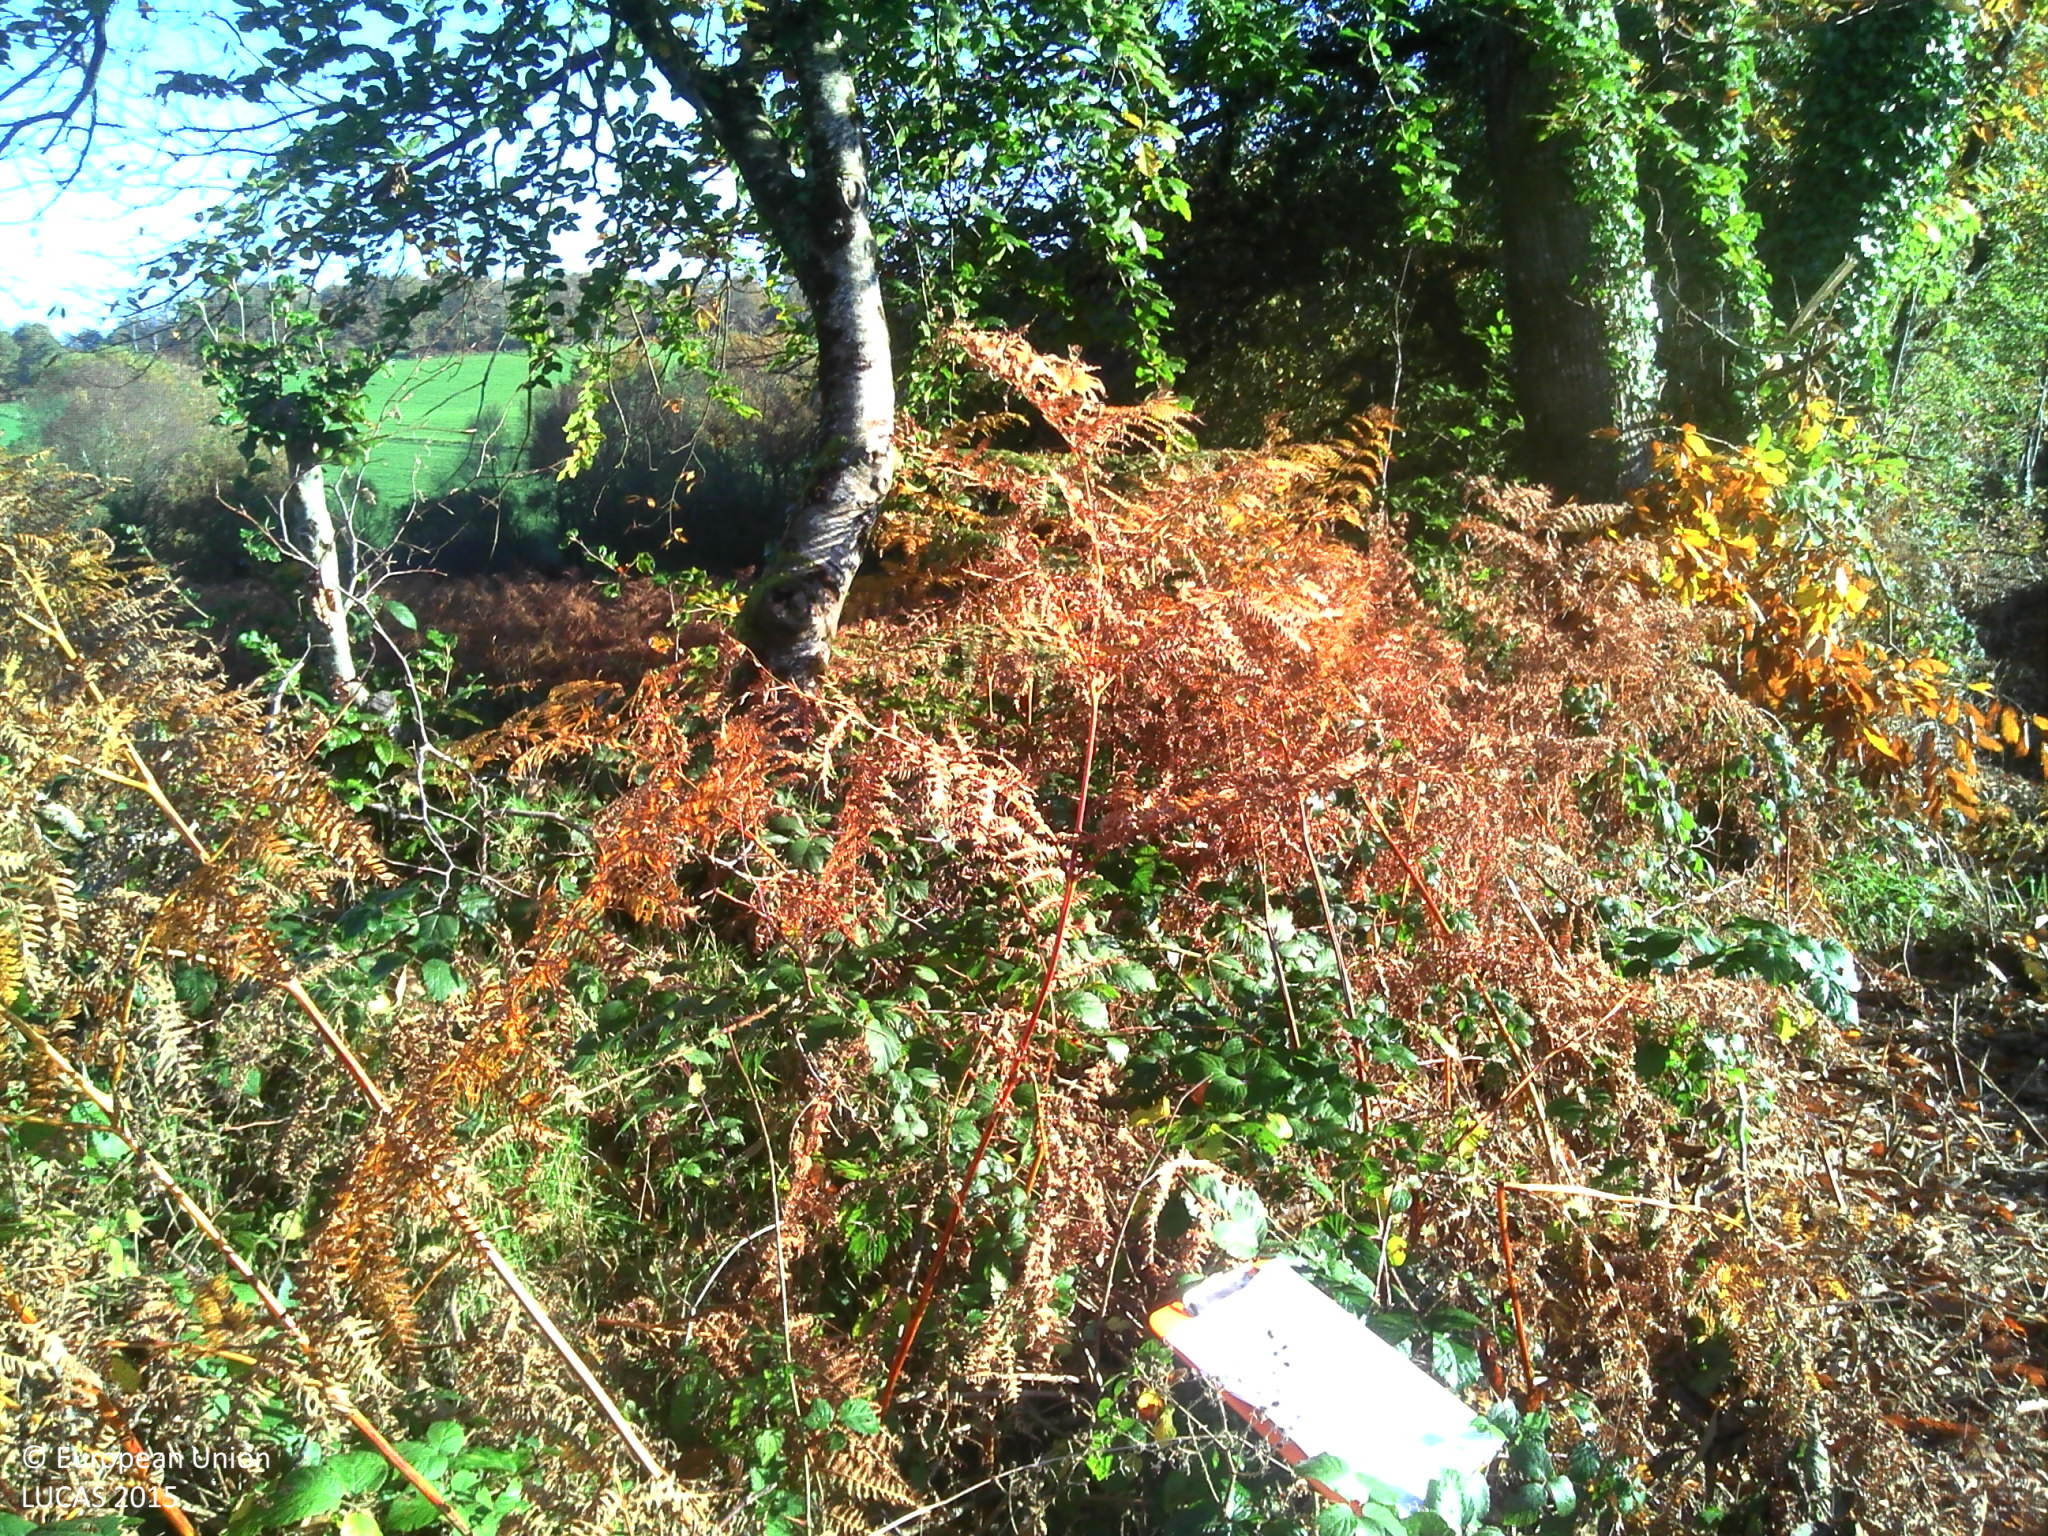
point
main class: Woodland
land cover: Broadleaved woodland
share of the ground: > 75 %
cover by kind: broadleaved forest trees 100 %
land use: Forestry
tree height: > 5 m
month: November
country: FR
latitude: 48.1091
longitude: -3.2757
